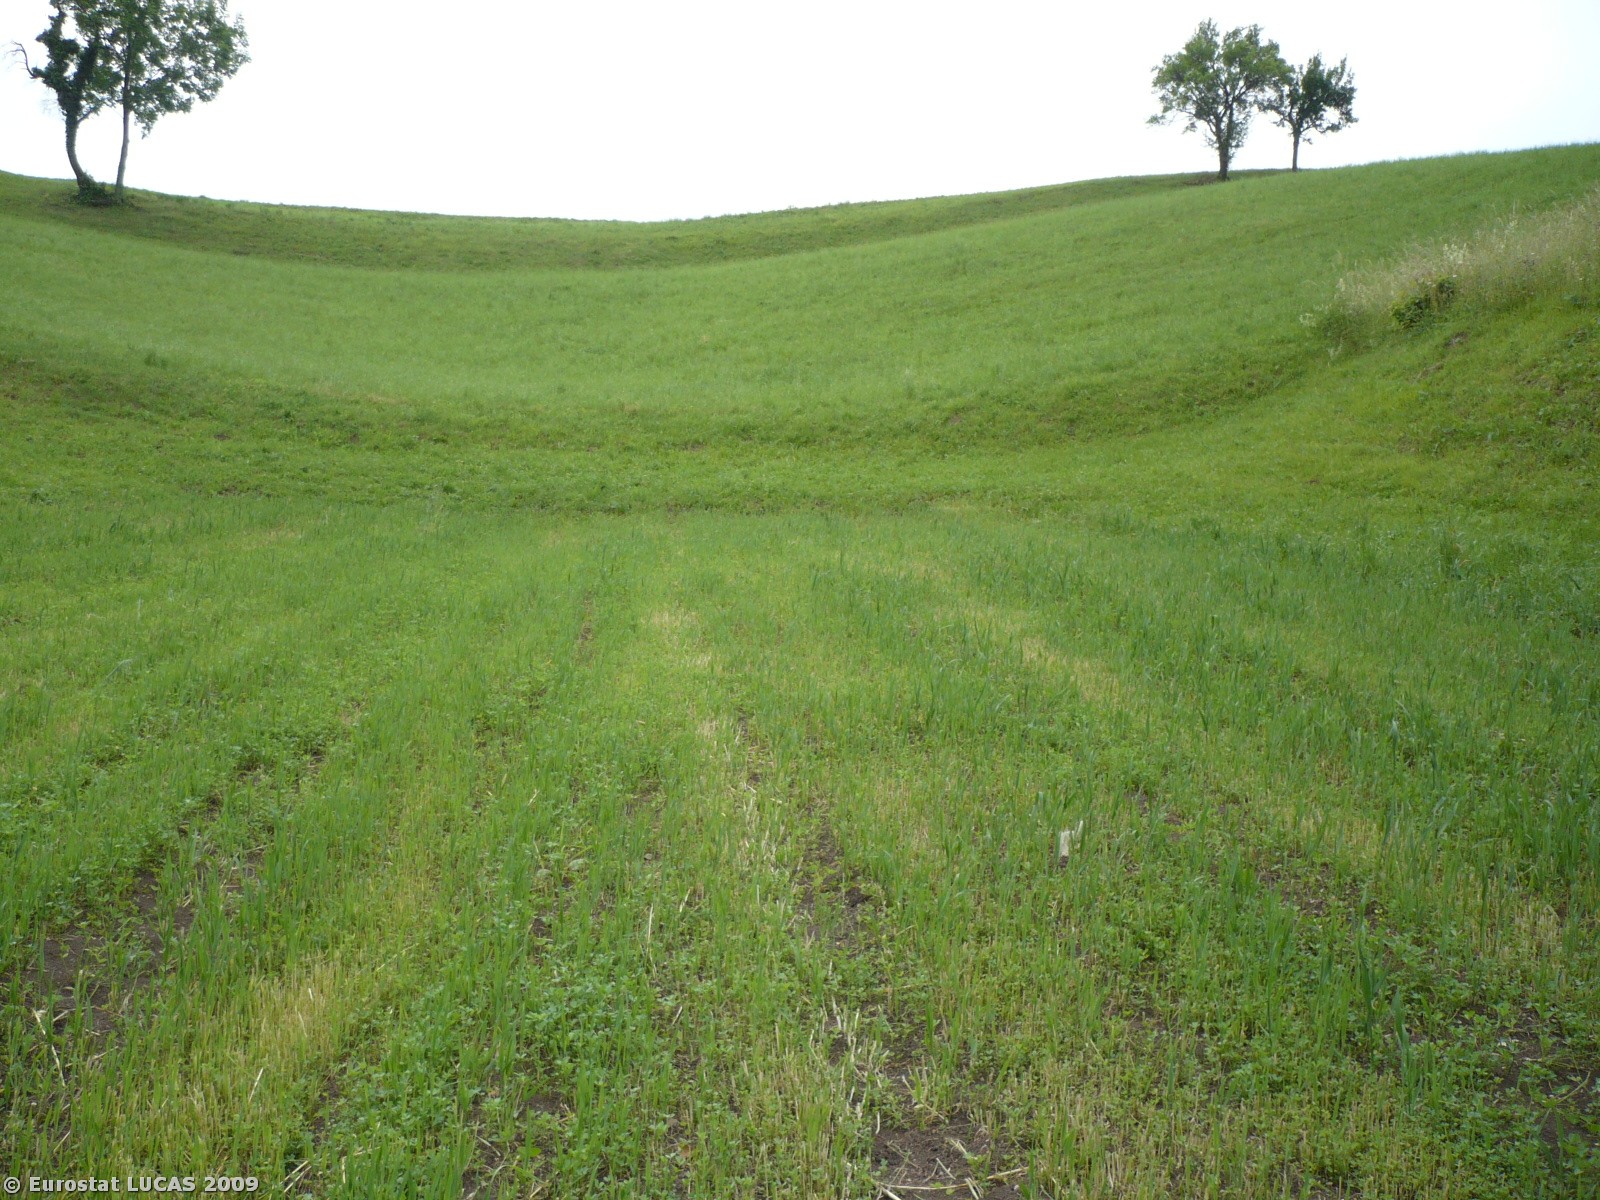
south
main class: Grassland
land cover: Spontaneously vegetated surfaces
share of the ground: > 75 %
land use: Fallow land
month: June
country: SI
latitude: 46.1300
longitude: 15.2911
